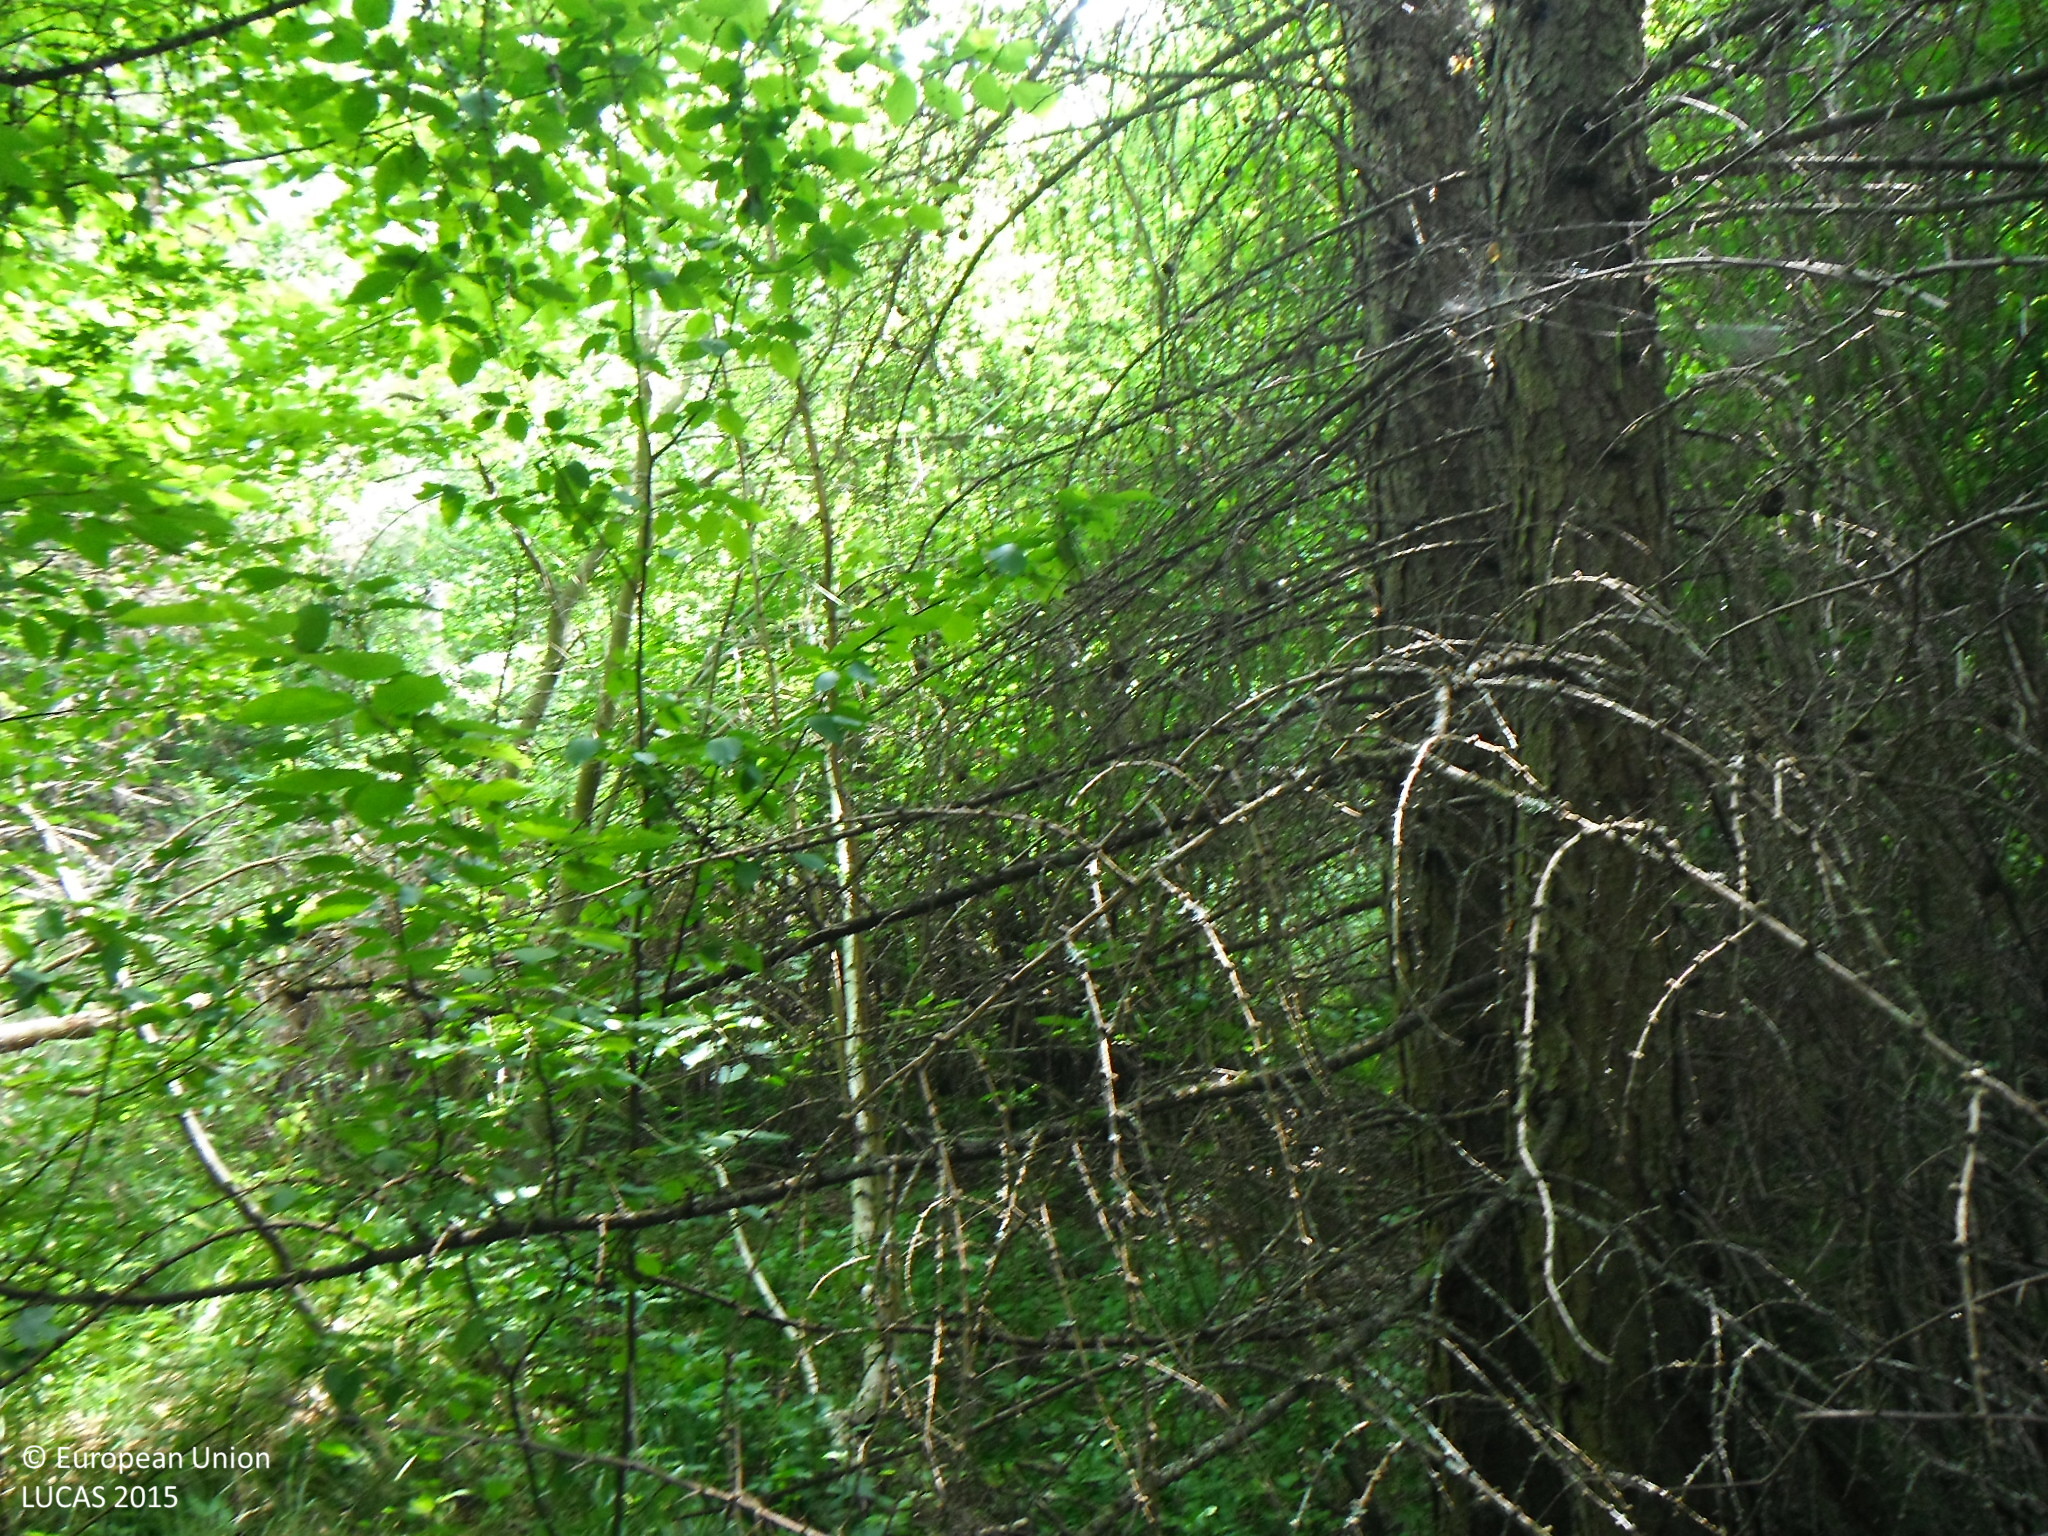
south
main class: Woodland
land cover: Broadleaved woodland
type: mesophytic deciduous forest
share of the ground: > 75 %
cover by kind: broadleaved forest trees 90 %, coniferous forest trees 10 %
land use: Forestry
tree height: > 5 m
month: July
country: SK
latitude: 49.1628
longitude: 22.0284
